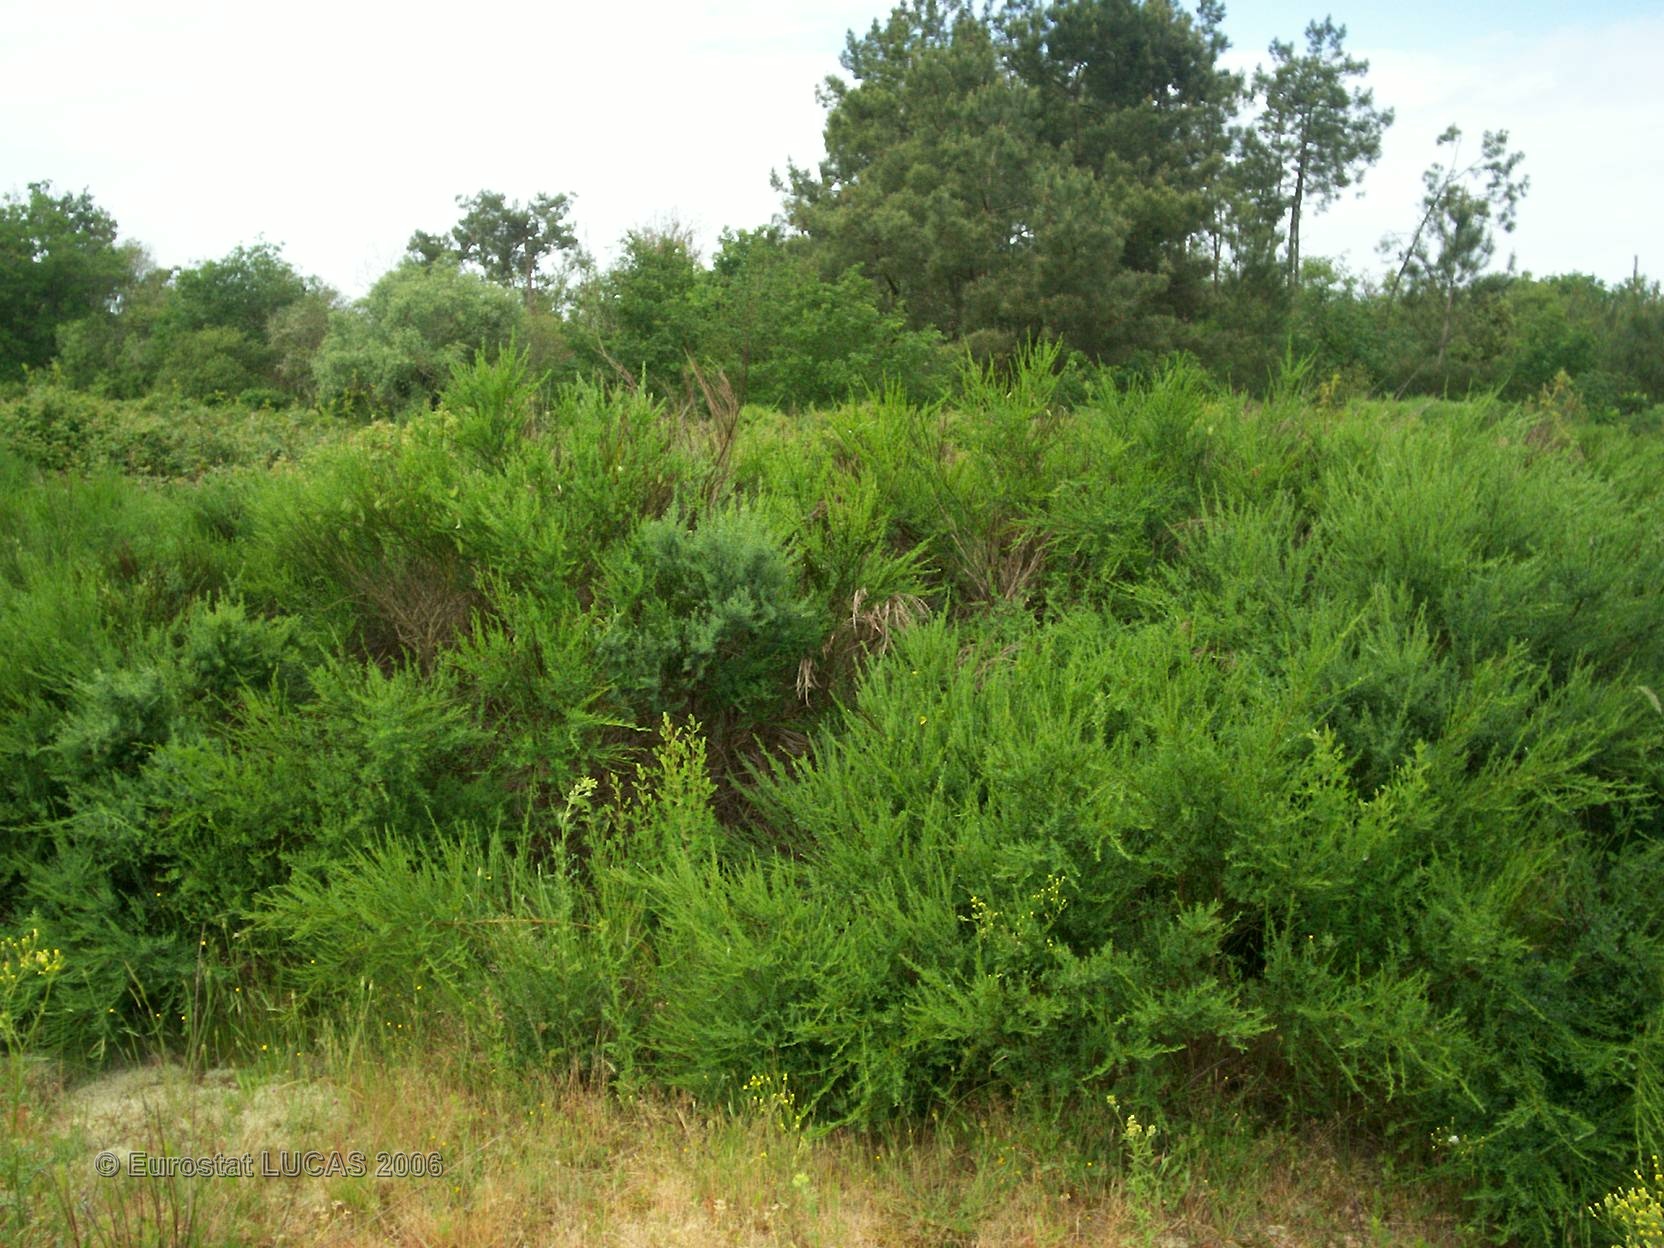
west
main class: Grassland
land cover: Grassland with sparse tree/shrub cover
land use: Unused
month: May
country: FR
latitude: 45.4156
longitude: -1.0288
